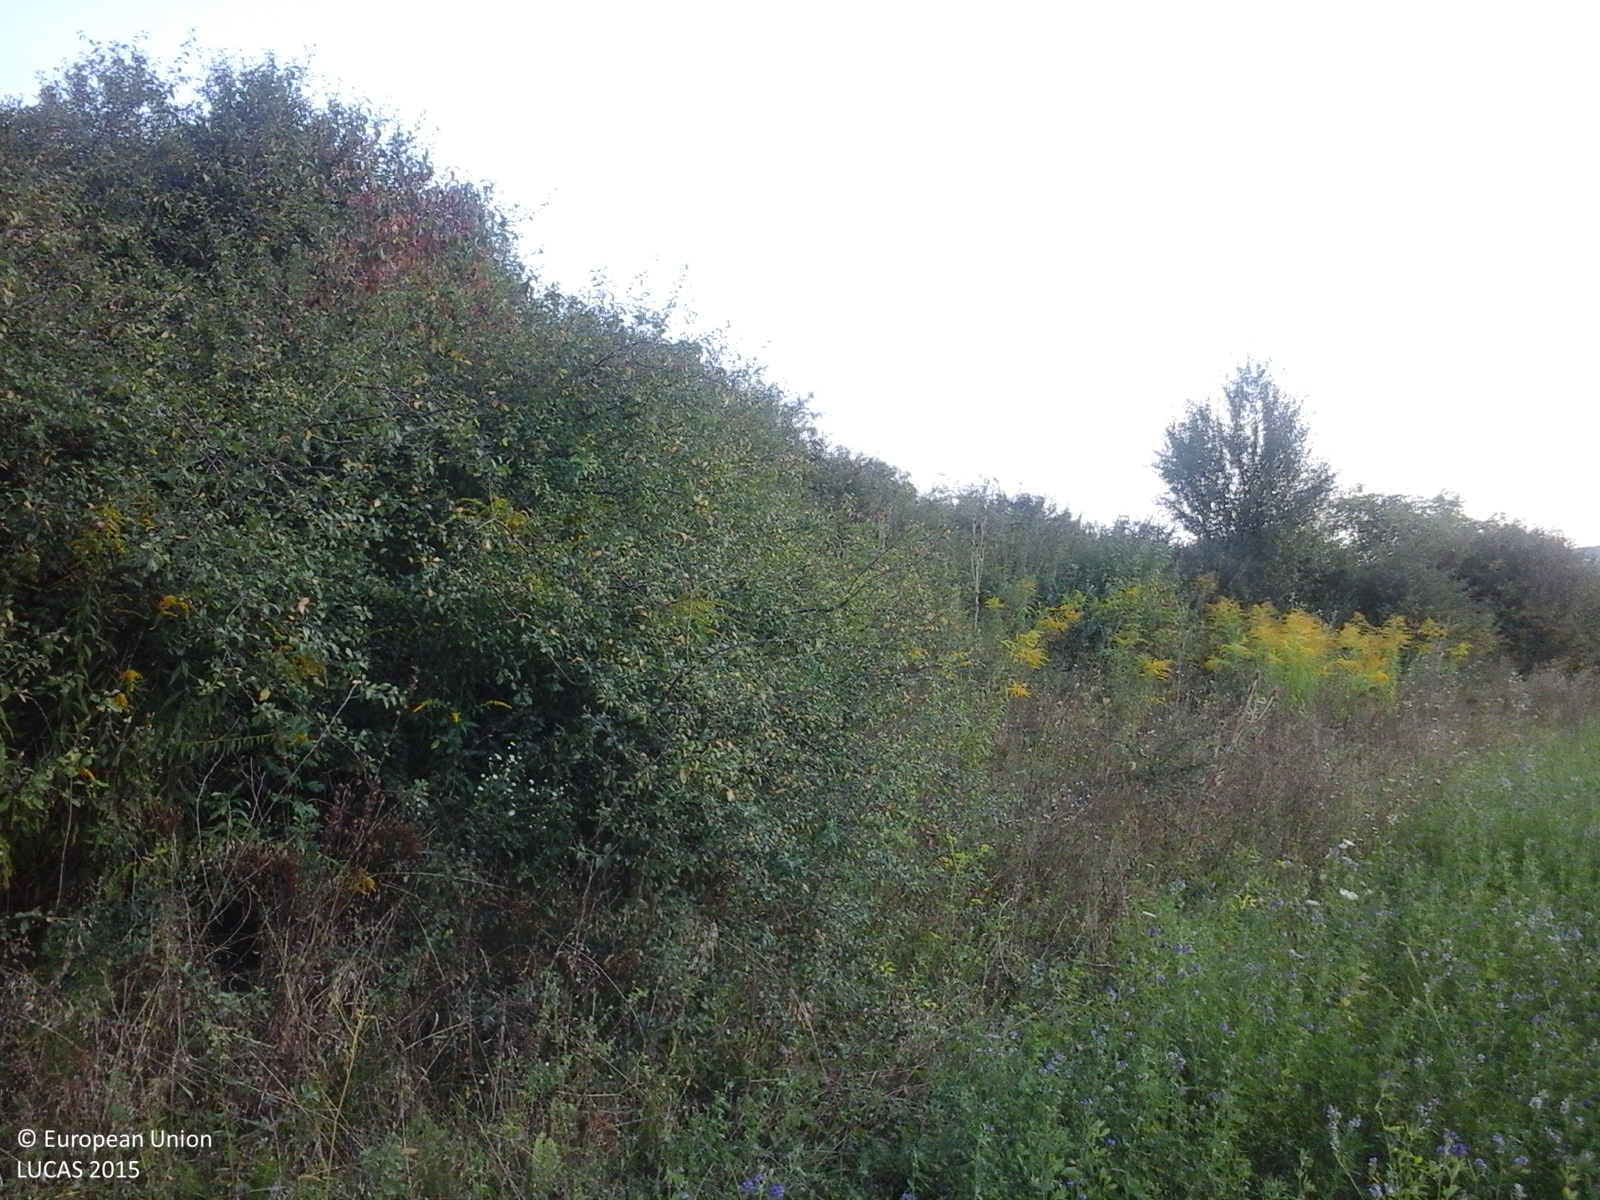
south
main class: Shrubland
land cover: Shrubland with sparse tree cover
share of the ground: > 75 %
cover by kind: shrubs 95 %, broadleaved forest trees 5 %
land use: Fallow land
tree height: > 5 m
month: September
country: RO
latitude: 47.0065
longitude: 24.1969
